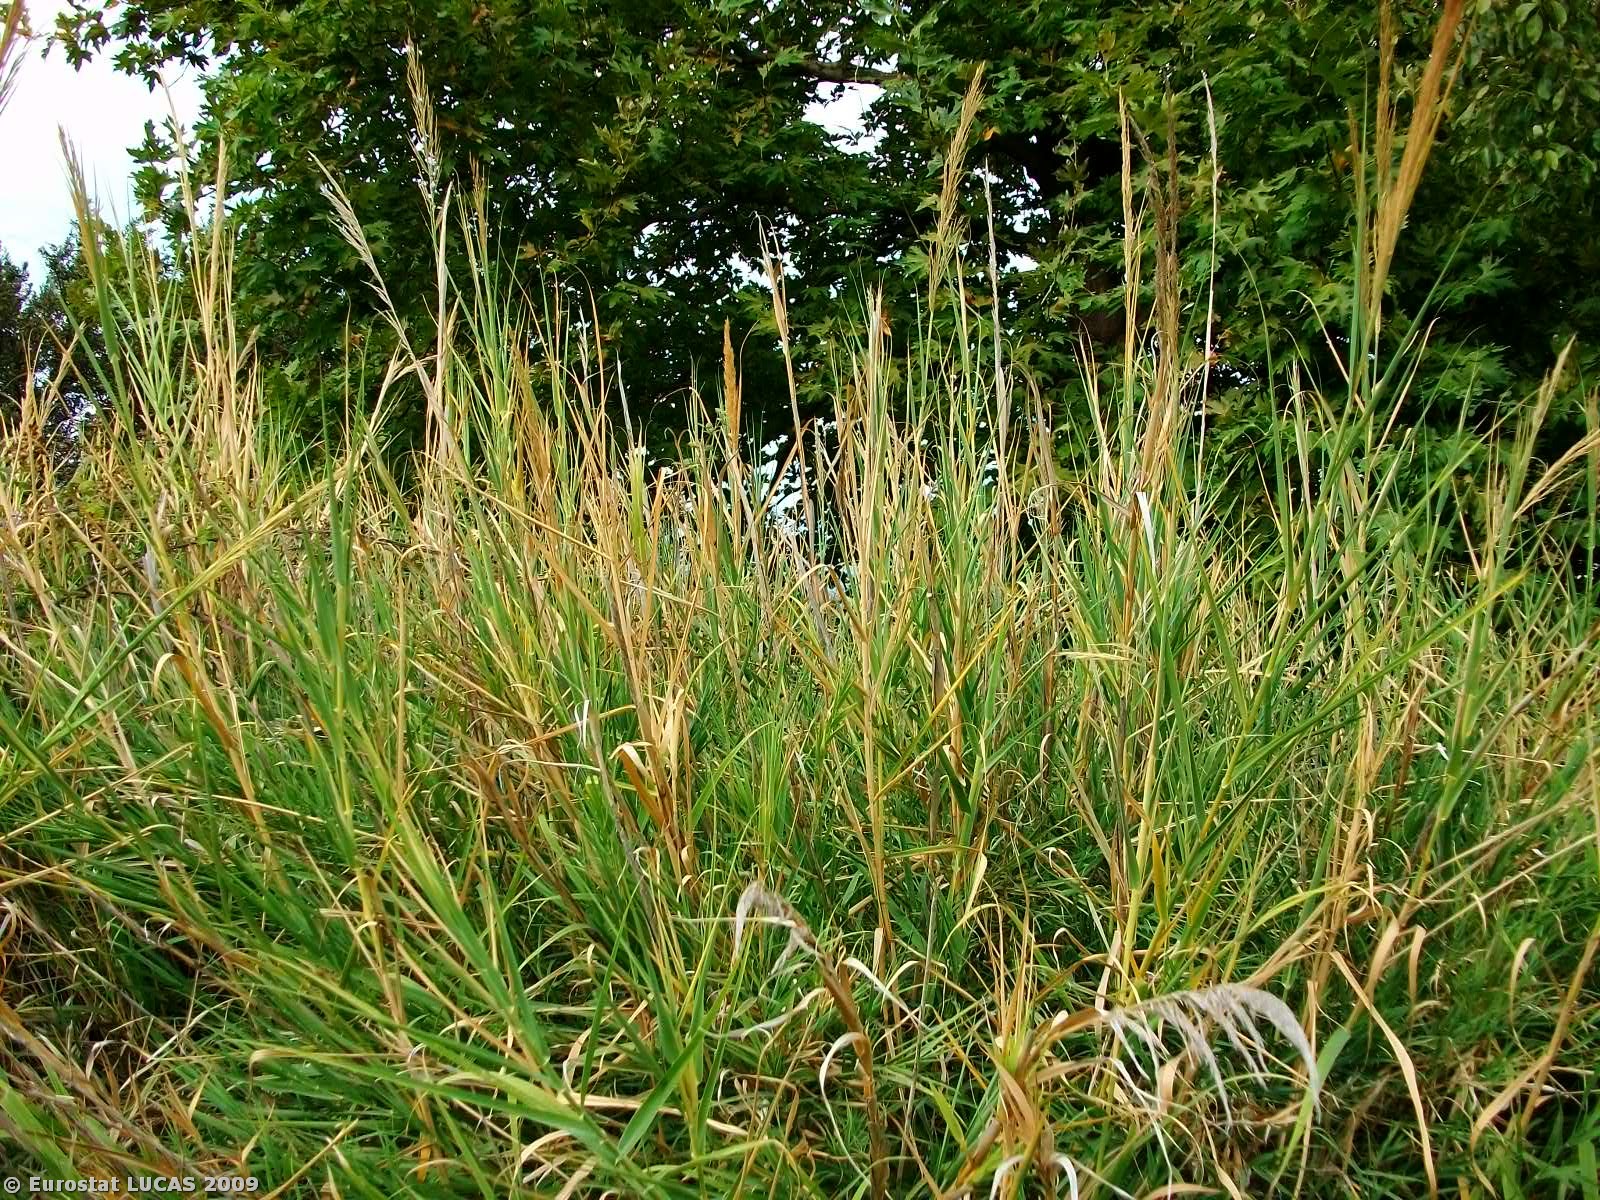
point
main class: Woodland
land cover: Broadleaved woodland
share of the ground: > 75 %
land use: Forestry
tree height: > 5 m
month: September
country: GR
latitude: 39.4319
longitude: 20.3014
